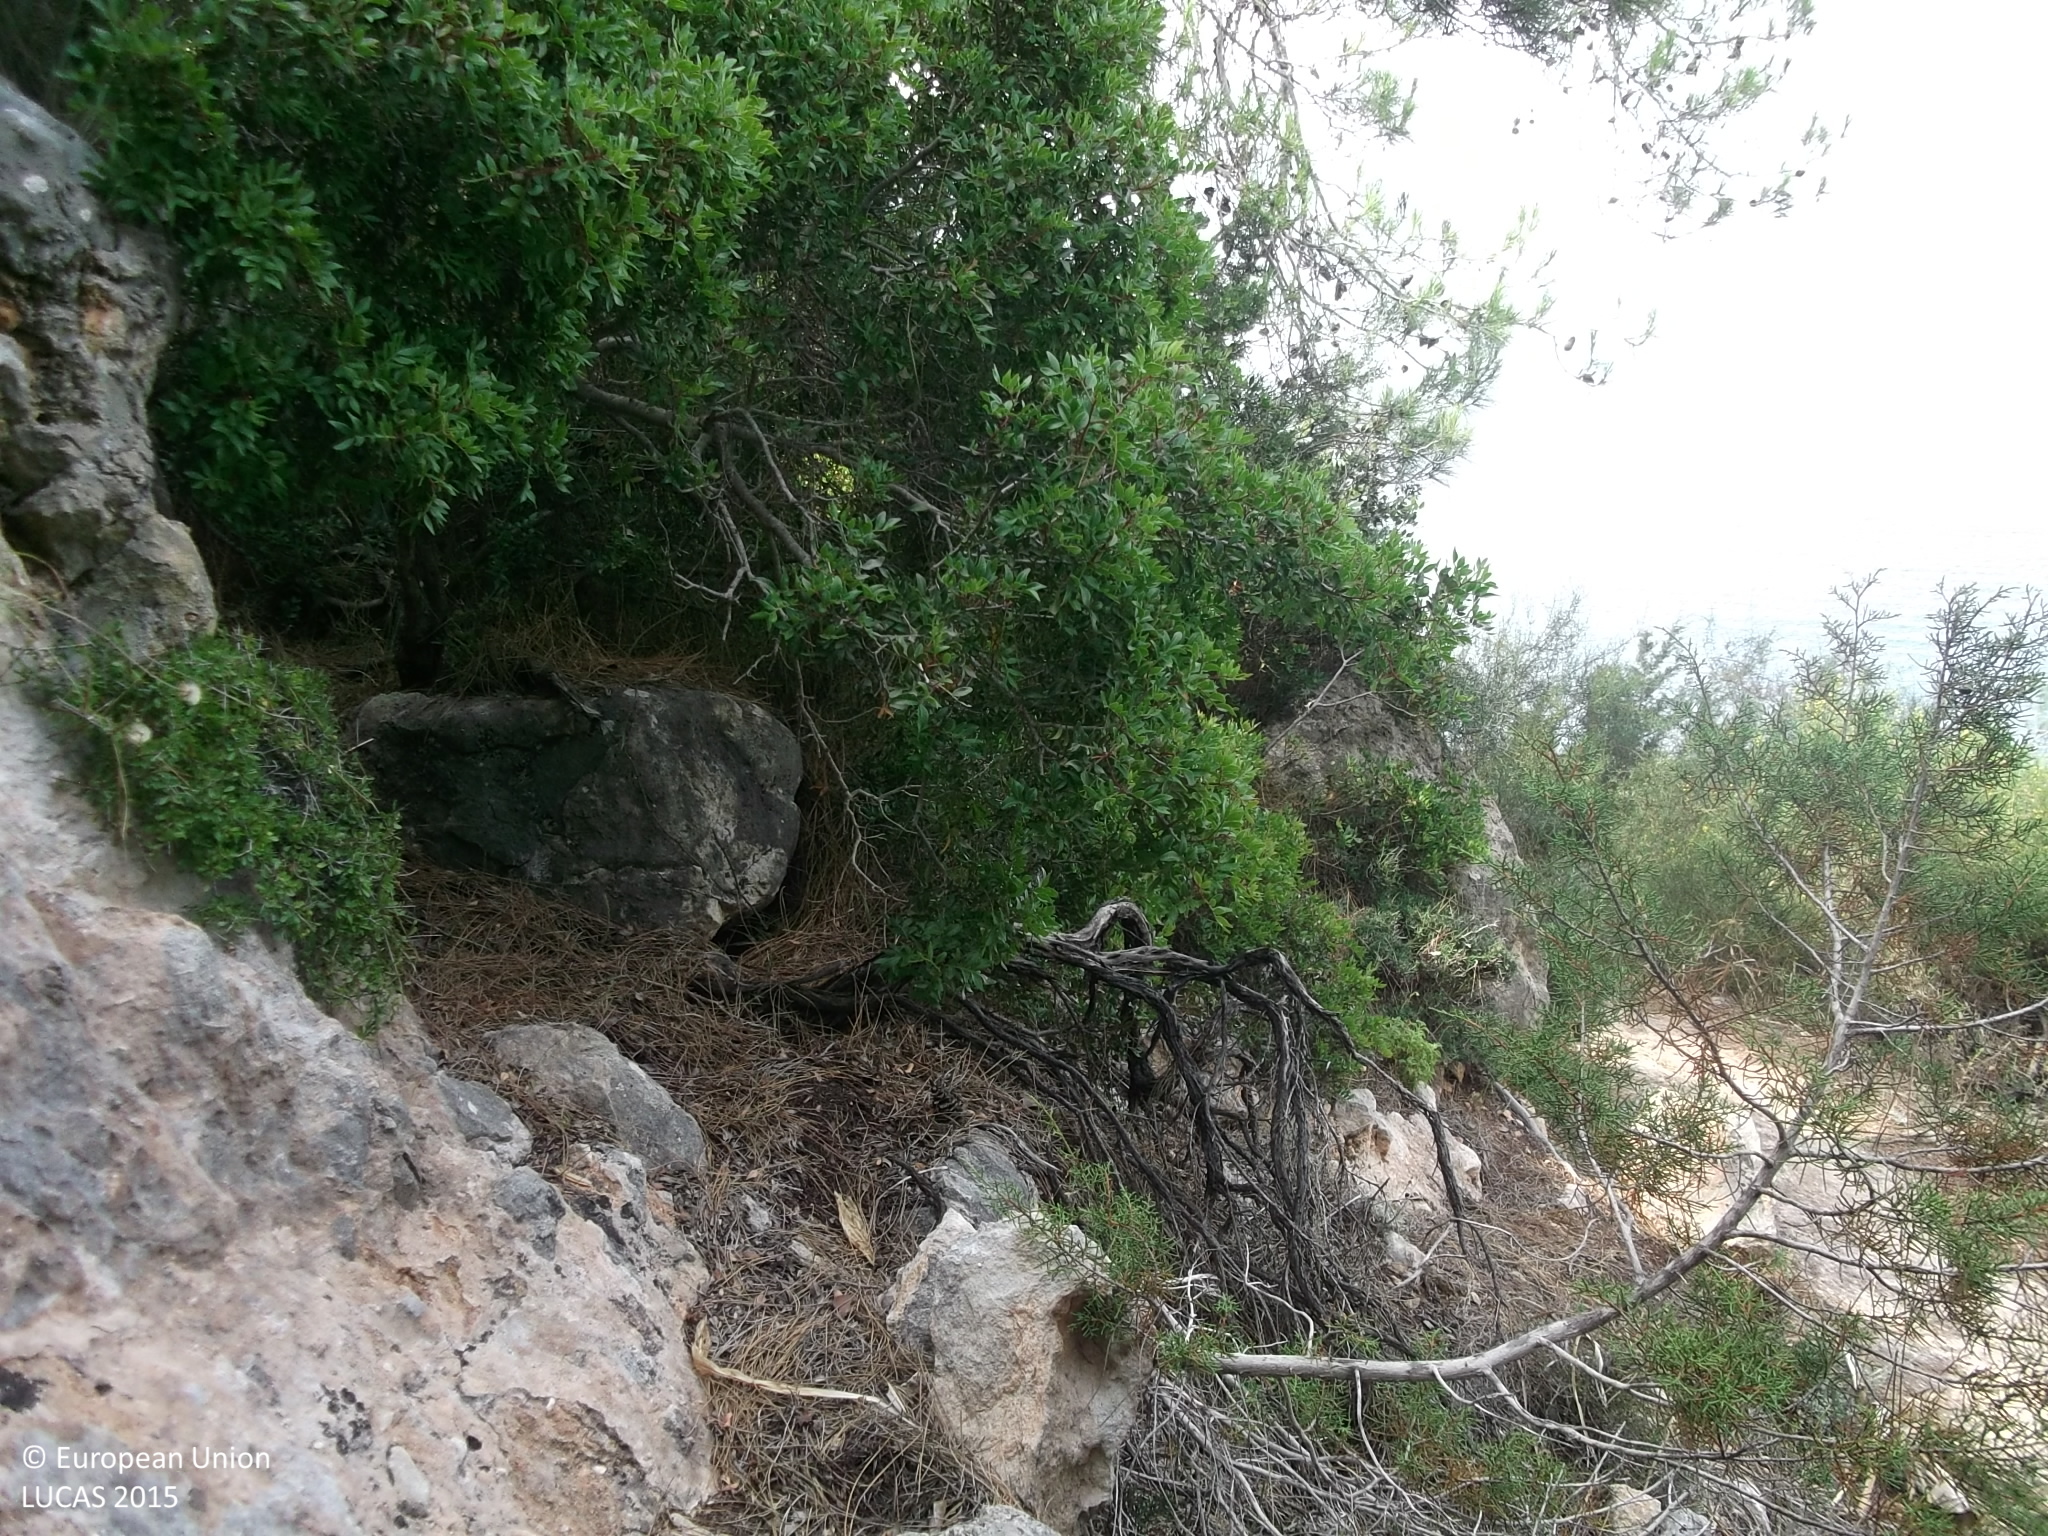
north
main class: Woodland
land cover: Pine dominated coniferous woodland
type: coniferous forest of the mediterranean region
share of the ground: 50 - 75 %
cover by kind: coniferous forest trees 75 %, unconsolidated bare surface 25 %
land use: Semi-natural and natural areas not in use
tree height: < 5 m
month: May
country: CY
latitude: 35.0559
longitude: 32.3311
